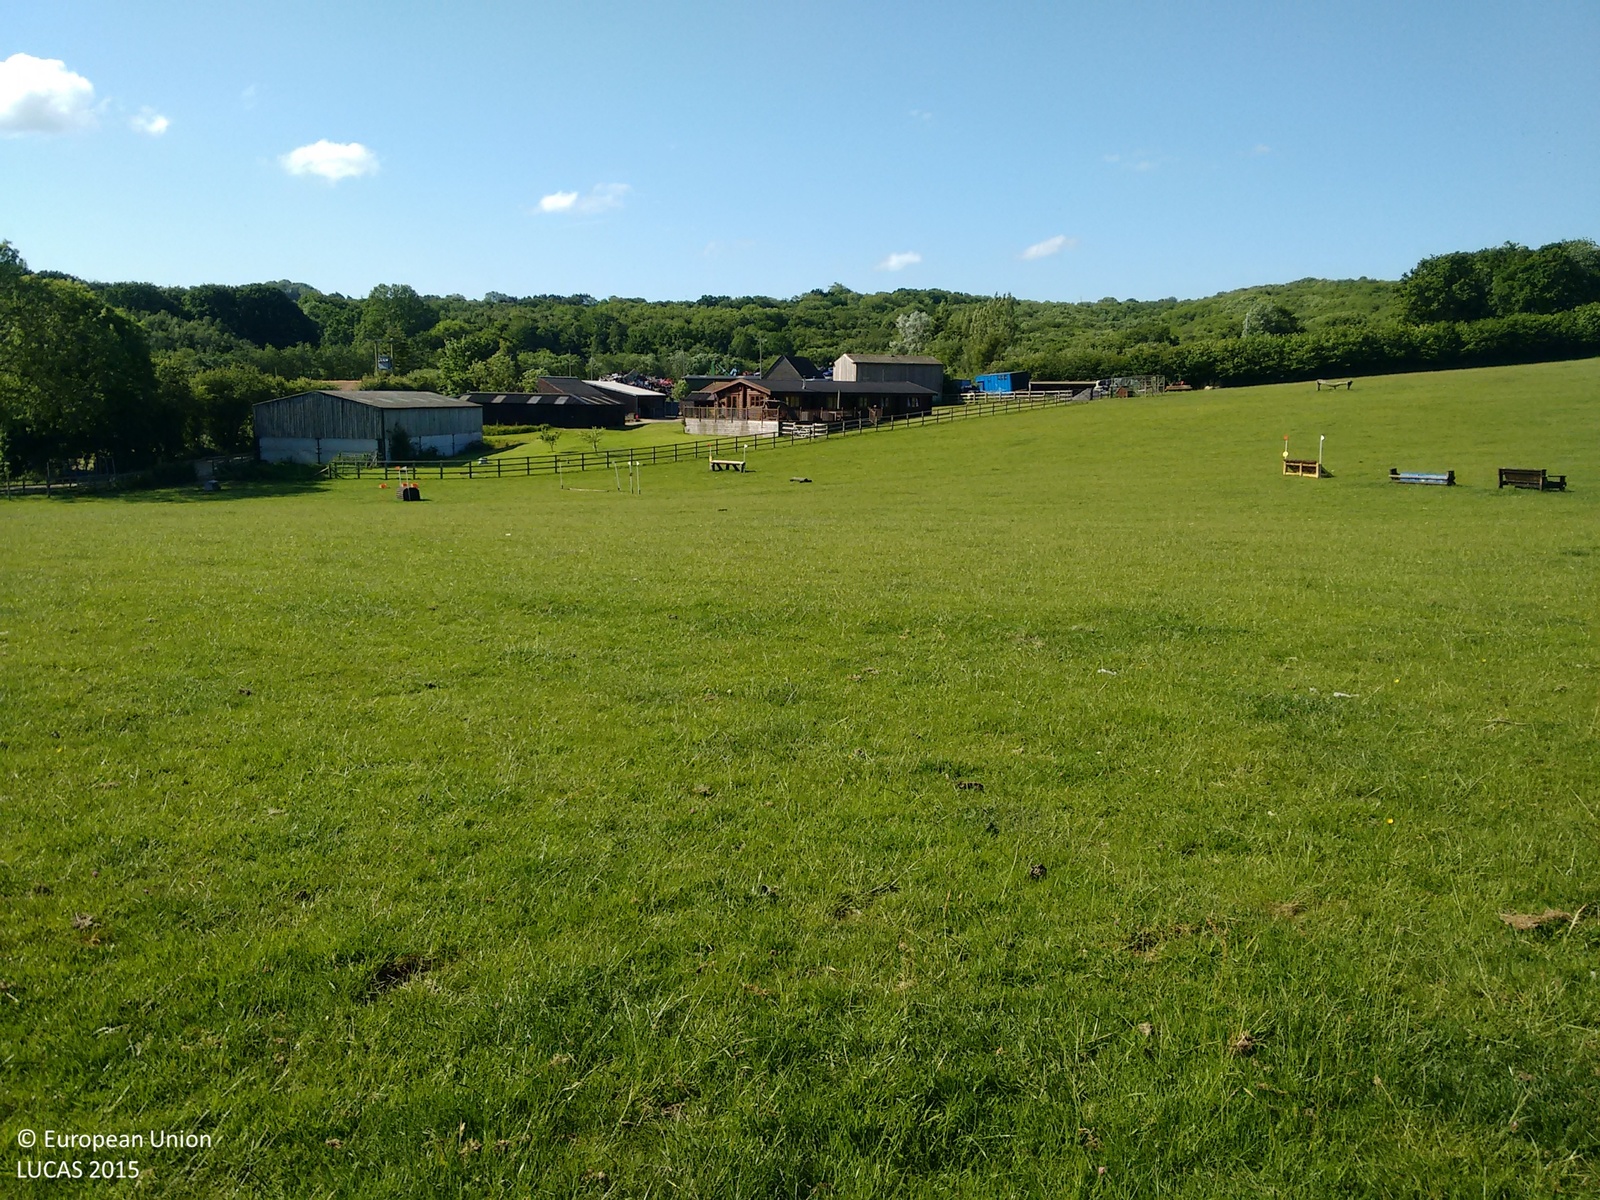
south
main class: Grassland
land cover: Grassland without tree/shrub cover
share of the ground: > 75 %
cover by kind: herbaceous plants 100 %
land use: Agriculture (excluding fallow land and kitchen gardens)
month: June
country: GB
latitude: 50.8974
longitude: 0.5746
